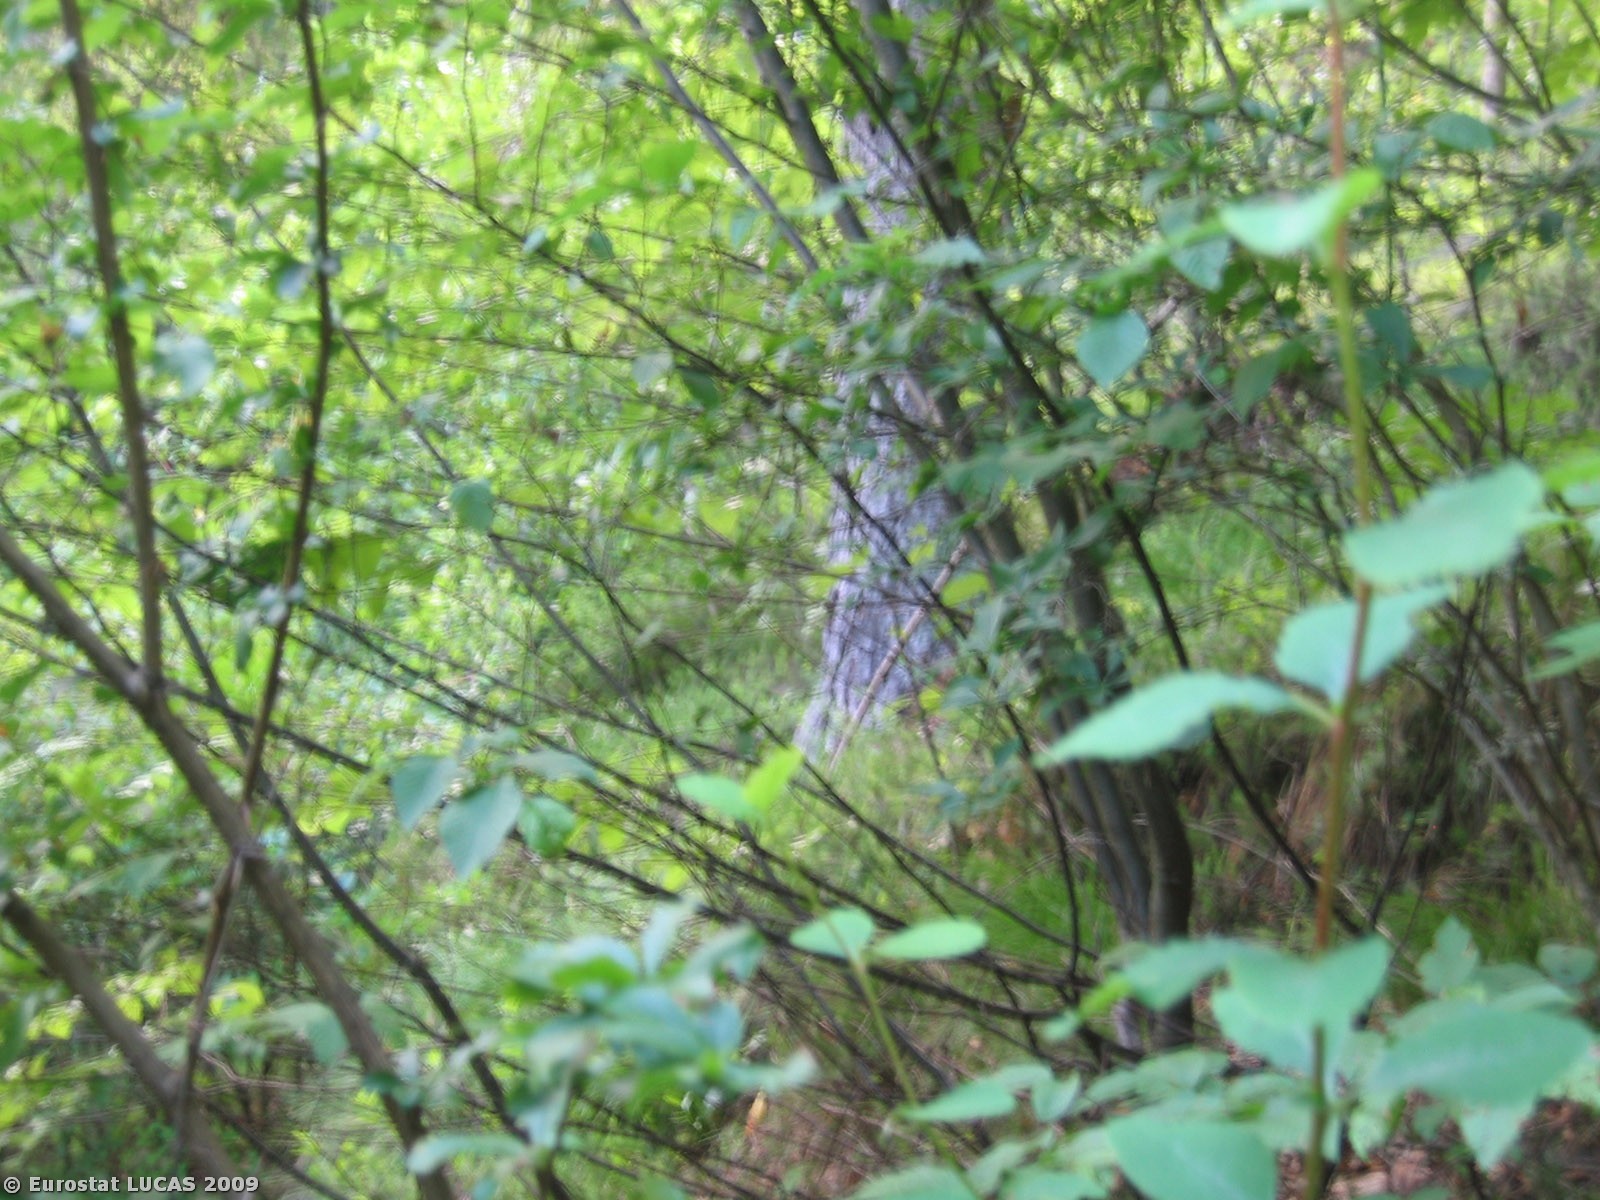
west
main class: Woodland
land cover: Broadleaved woodland
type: thermophilous deciduous forest
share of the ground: > 75 %
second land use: Forestry
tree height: > 5 m
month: June
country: SI
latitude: 46.0653
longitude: 14.3272
